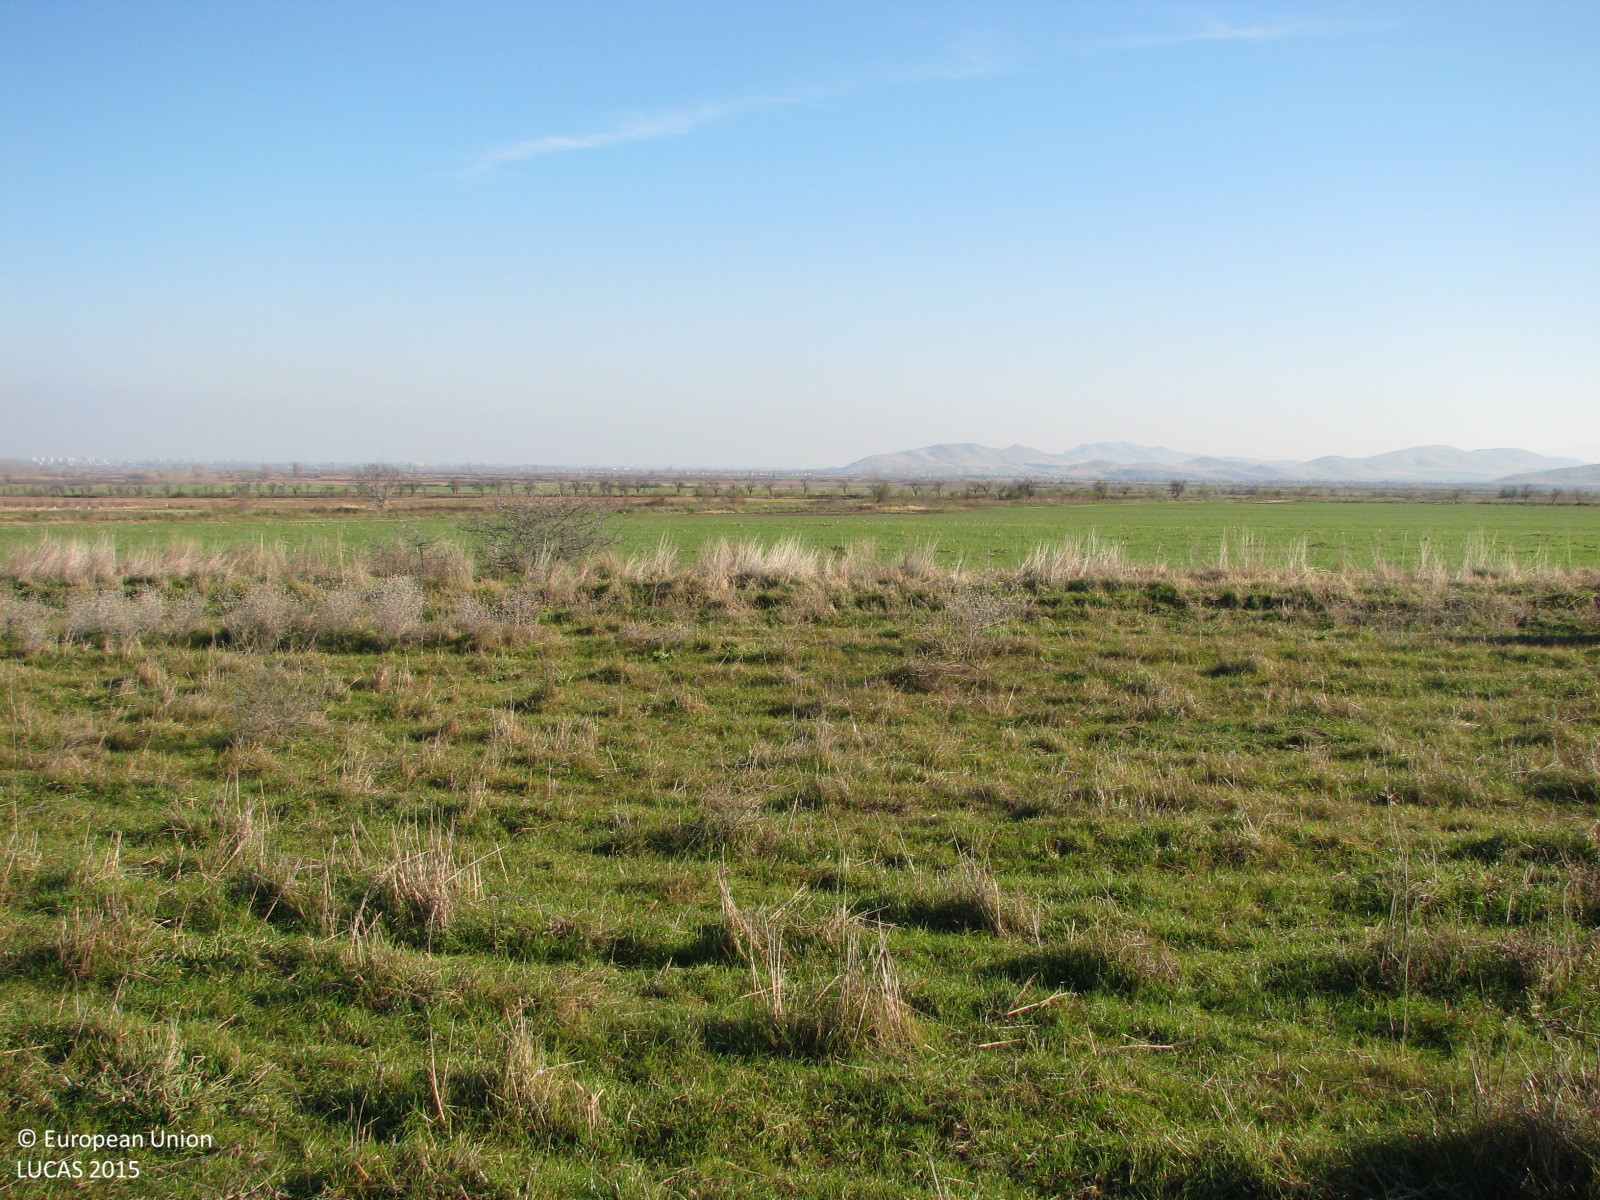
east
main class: Grassland
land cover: Spontaneously vegetated surfaces
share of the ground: > 75 %
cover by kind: herbaceous plants 95 %, unconsolidated bare surface 5 %
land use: Agriculture (excluding fallow land and kitchen gardens)
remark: Harvested field
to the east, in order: Spontaneously vegetated surfaces; Ditches and canals; Grass margins; Common wheat
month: December
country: BG
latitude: 42.1406
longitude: 24.2106
